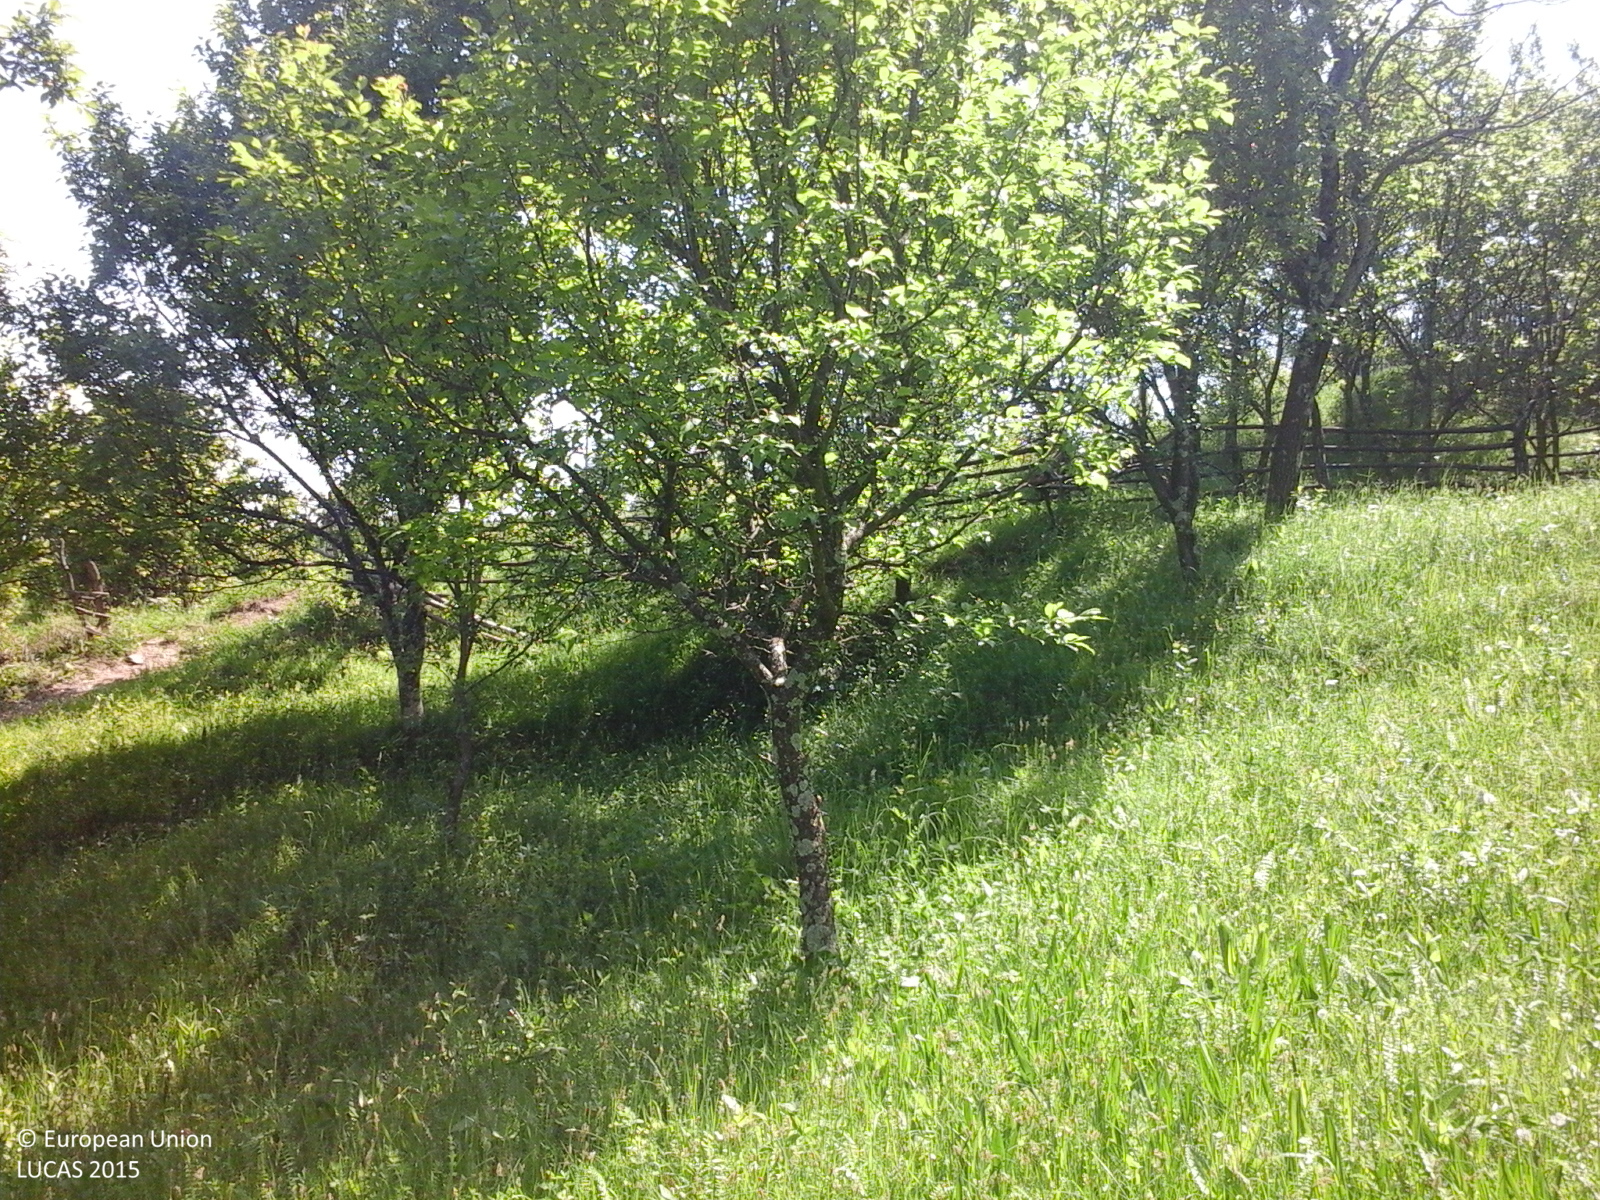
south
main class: Cropland
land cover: Other fruit trees and berries
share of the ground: 50 - 75 %
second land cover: Grassland without tree/shrub cover
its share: > 75 %
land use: Agriculture (excluding fallow land and kitchen gardens)
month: May
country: RO
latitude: 45.4772
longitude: 26.4077
